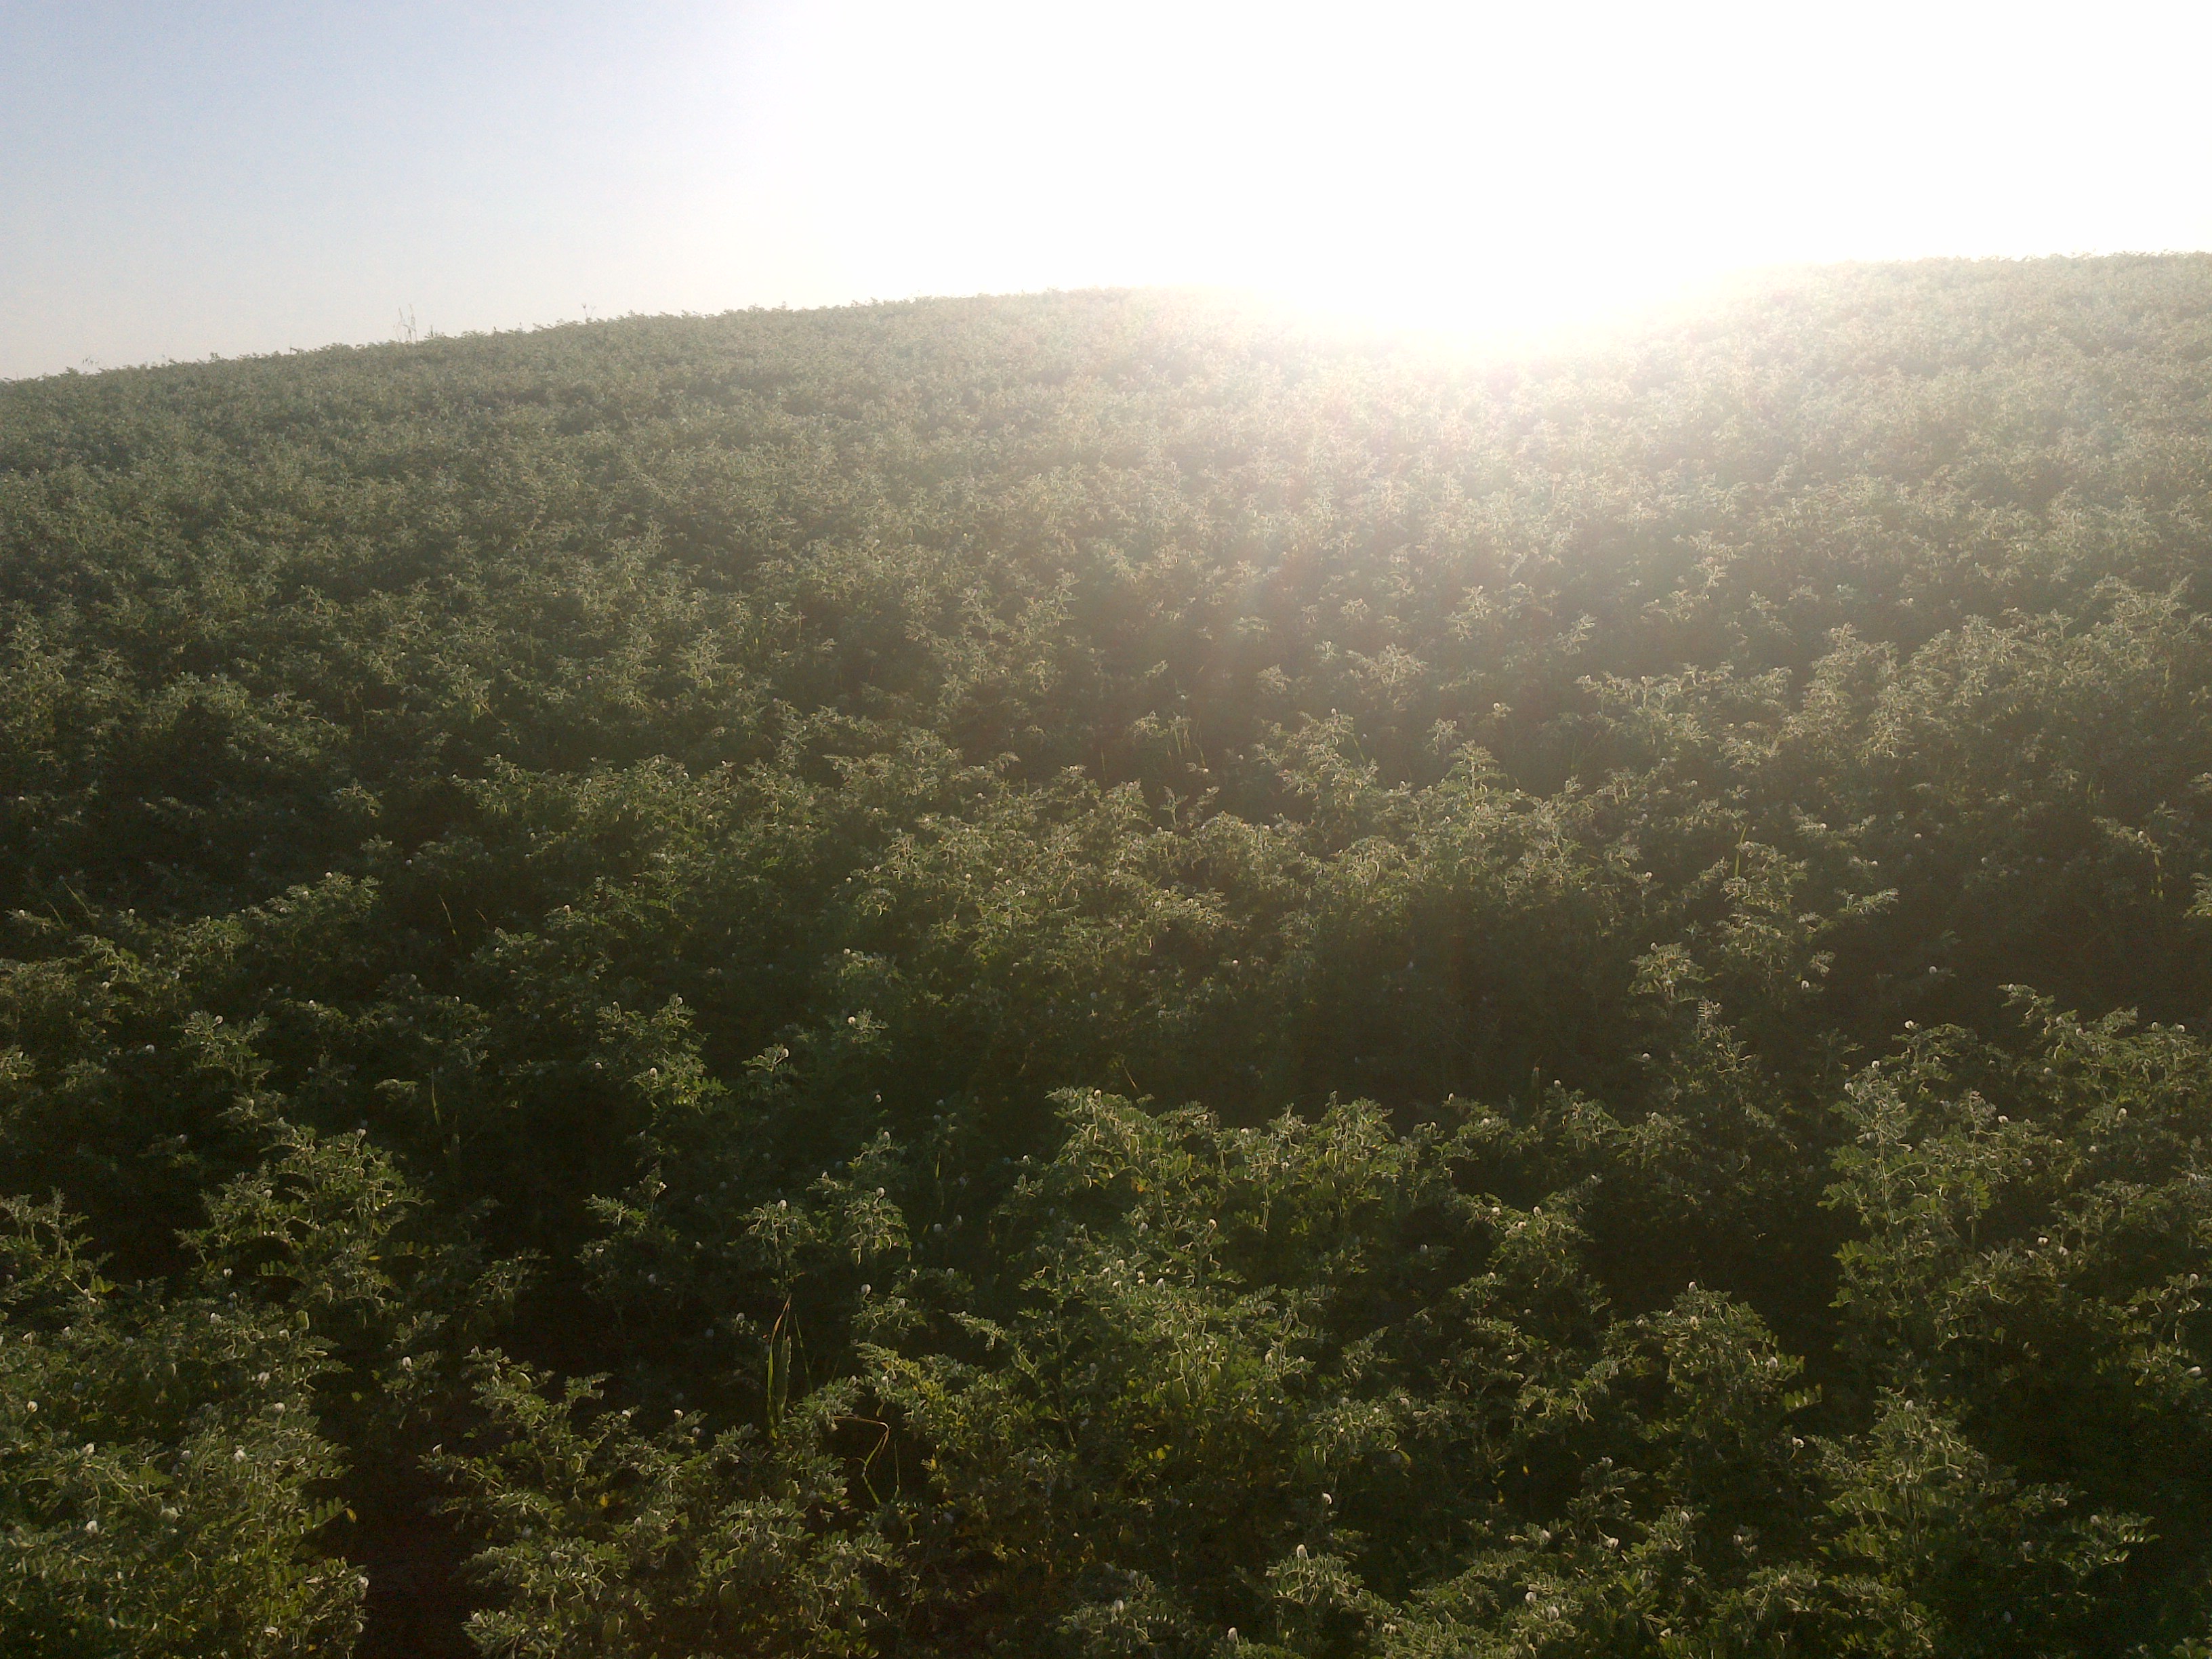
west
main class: Cropland
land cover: Dry pulses
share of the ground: > 75 %
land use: Agriculture (excluding fallow land and kitchen gardens)
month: May
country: ES
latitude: 37.8858
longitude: -4.4619
